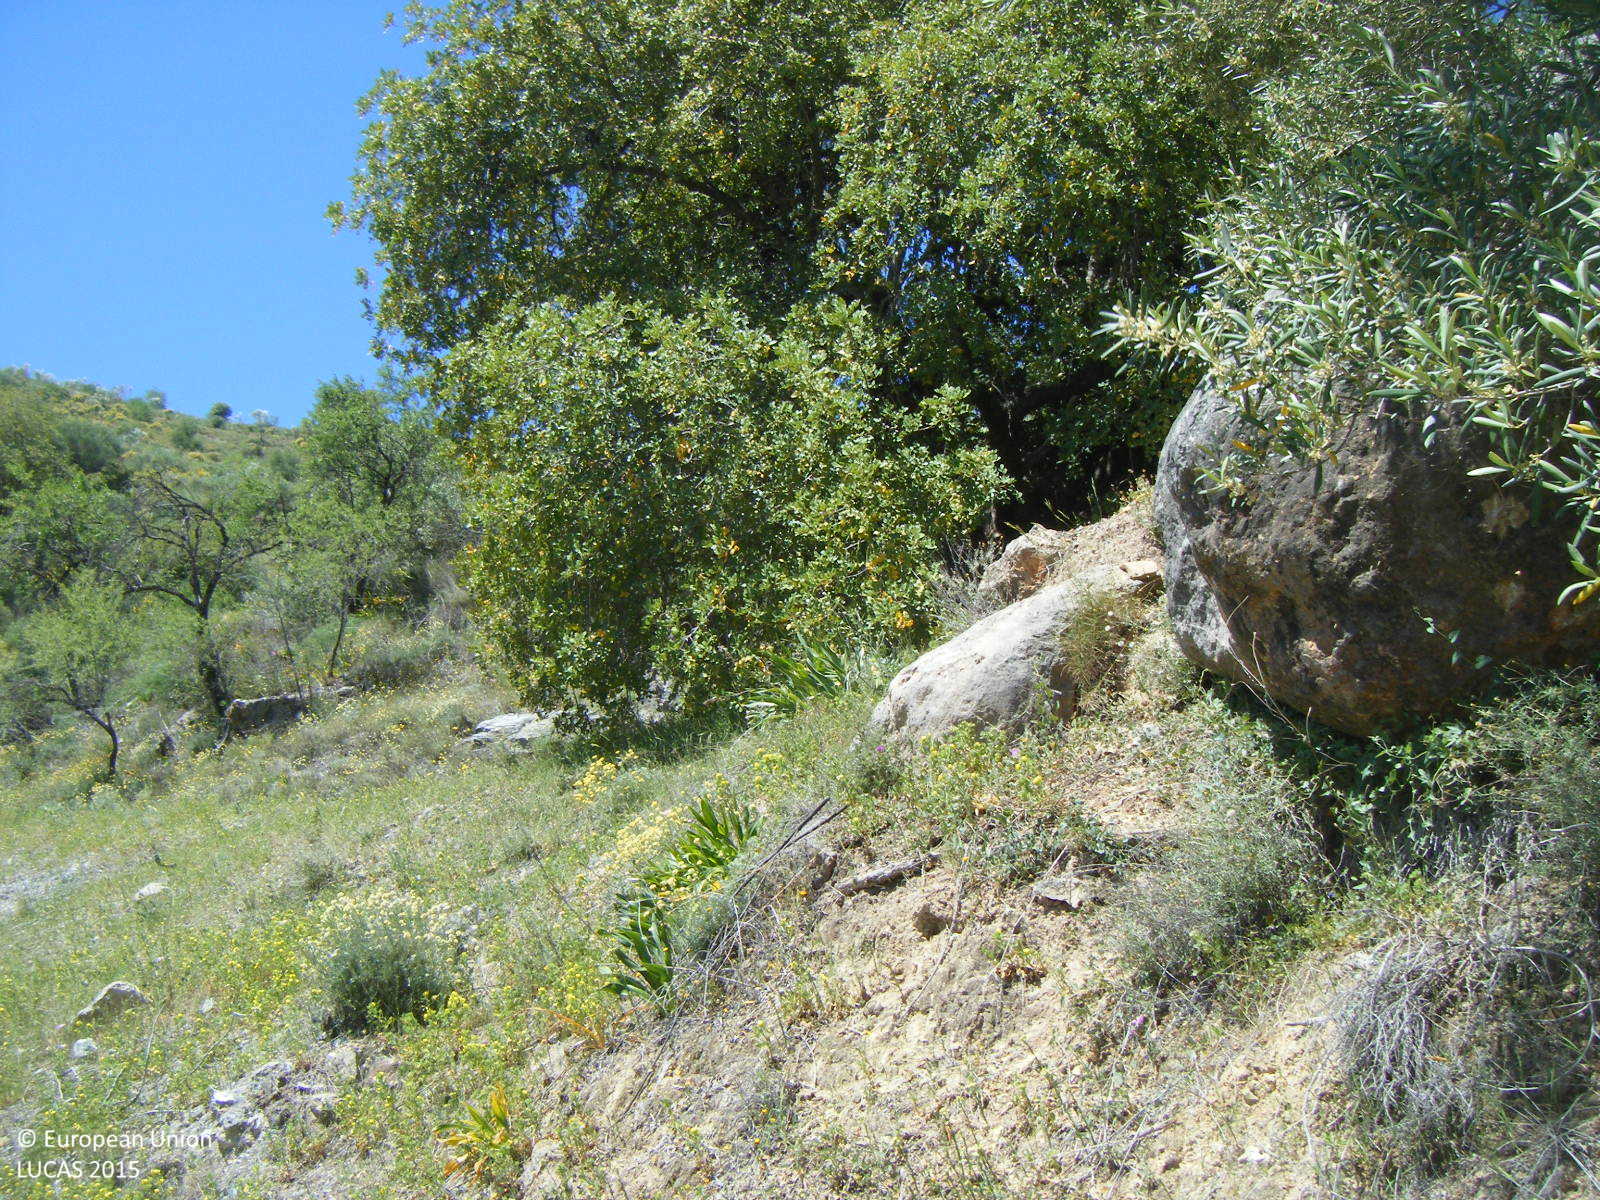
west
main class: Cropland
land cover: Olive groves
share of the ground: 10 - 25 %
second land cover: Spontaneously vegetated surfaces
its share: > 75 %
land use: Agriculture (excluding fallow land and kitchen gardens)
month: May
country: ES
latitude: 36.9095
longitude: -4.7109
